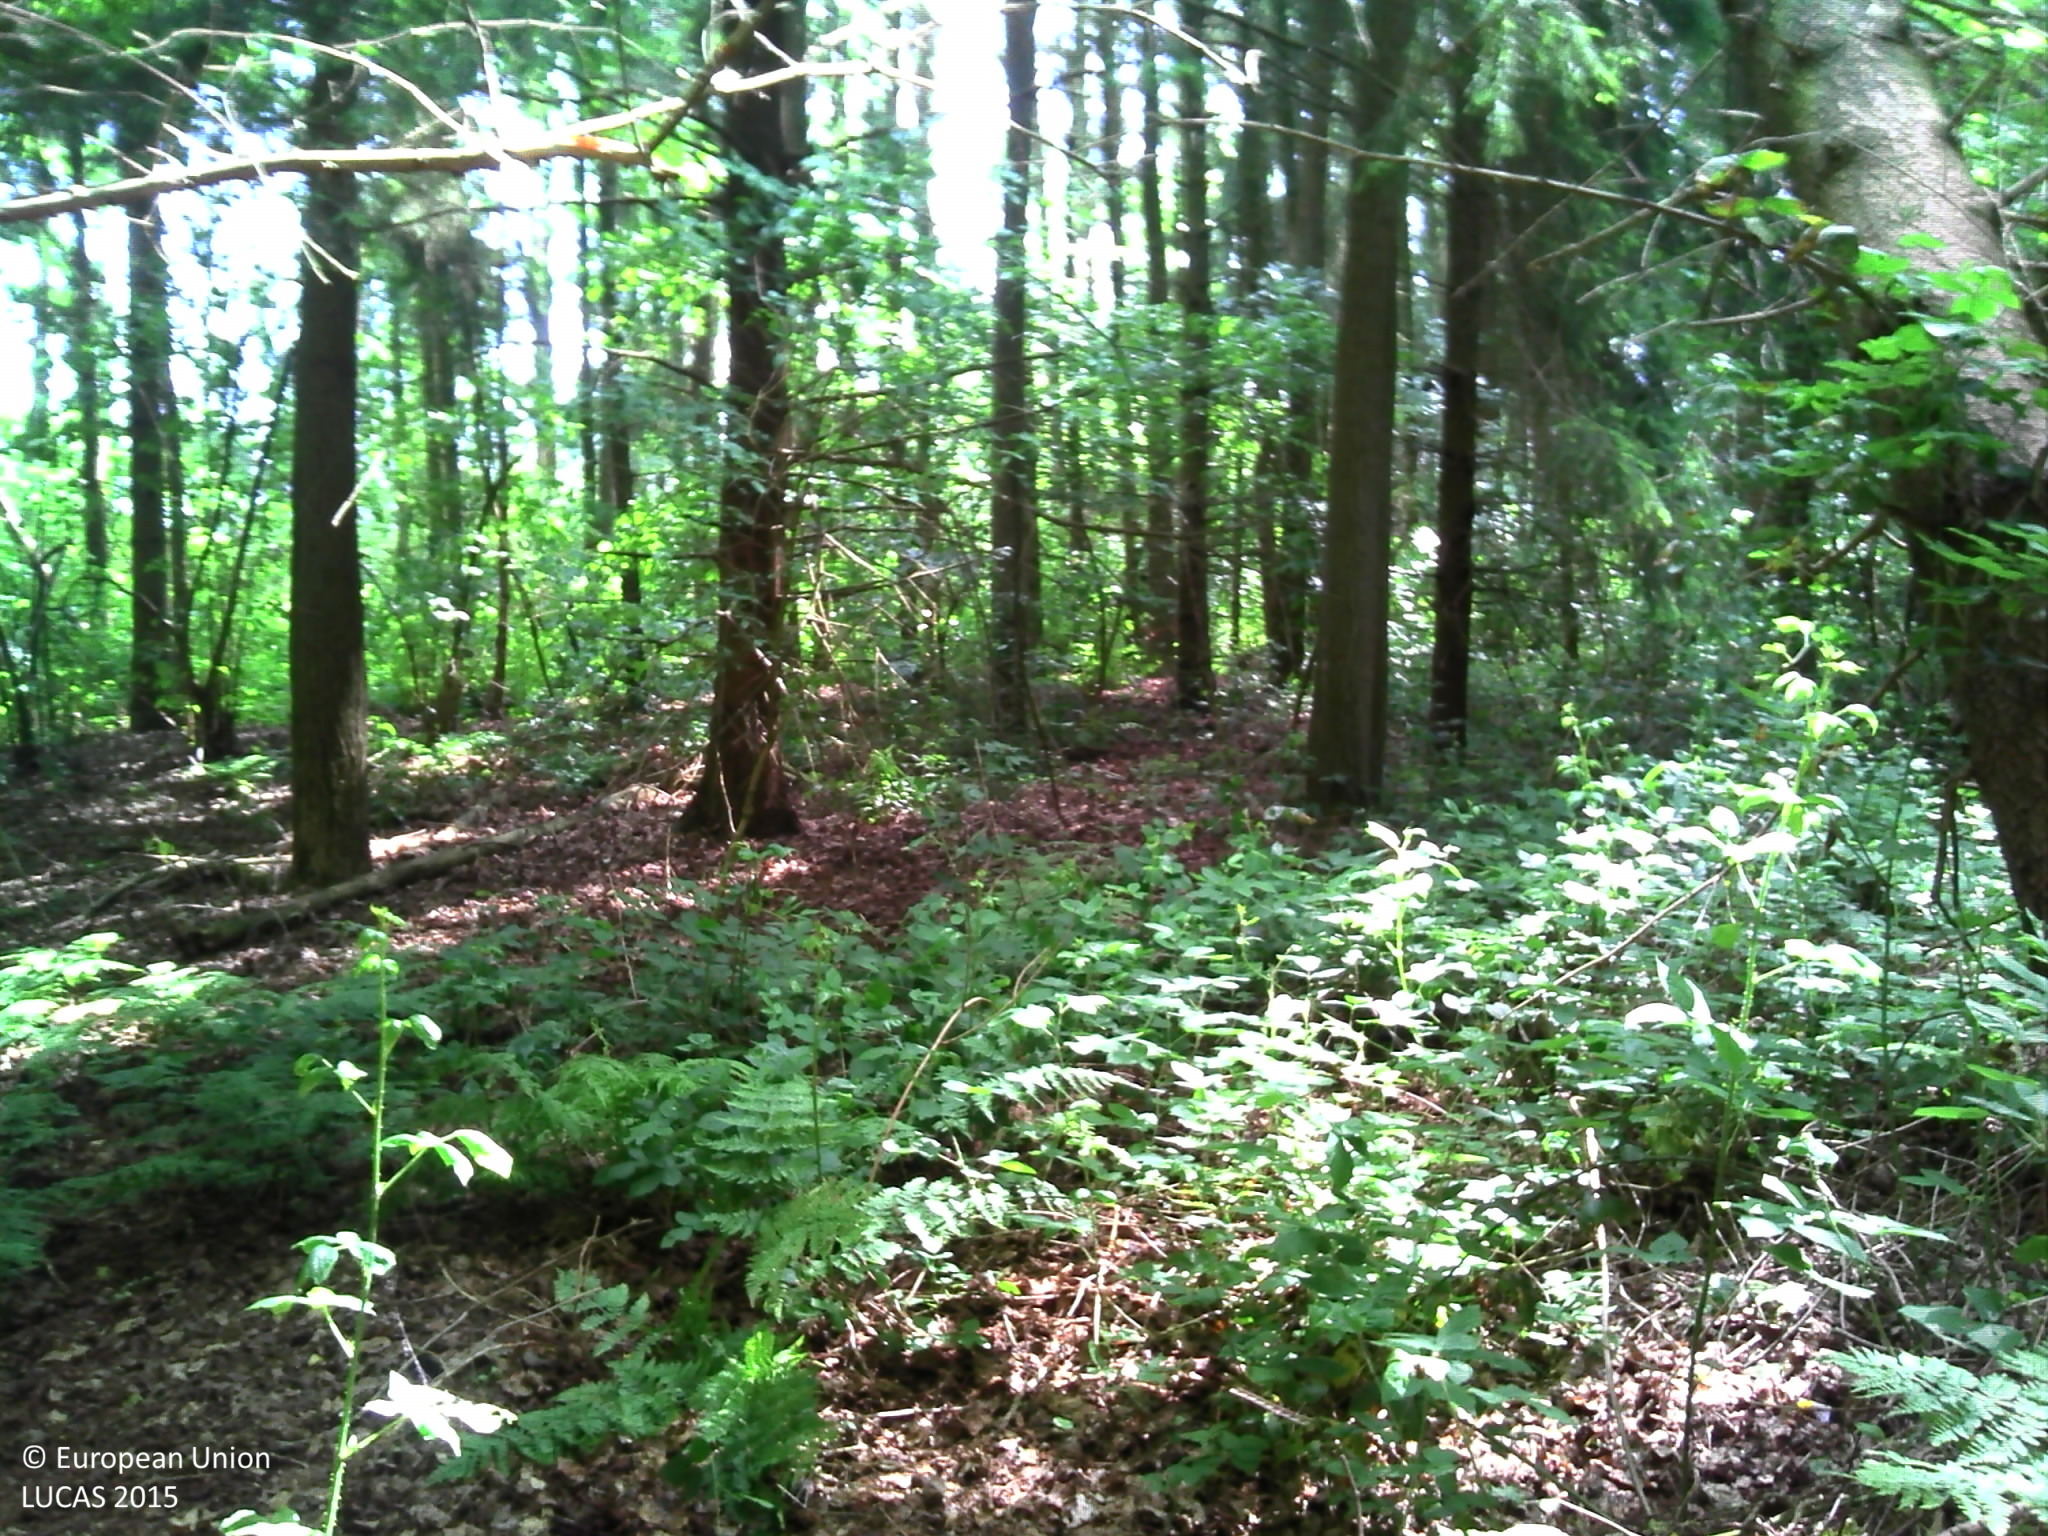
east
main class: Woodland
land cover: Spruce dominated coniferous woodland
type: hemiboreal forest and nemoral coniferous forest and mixed broadleaved-coniferous forest
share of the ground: > 75 %
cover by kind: coniferous forest trees 100 %
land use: Forestry
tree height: > 5 m
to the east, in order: Spruce dominated coniferous woodland; Tracks; Spruce dominated mixed woodland; Ditches and canals; Broadleaved woodland; Abandoned hedges; Grassland without tree/shrub cover; Fences; Grassland without tree/shrub cover; Fences; Grassland without tree/shrub cover
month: June
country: BE
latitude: 50.9400
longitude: 3.8885
